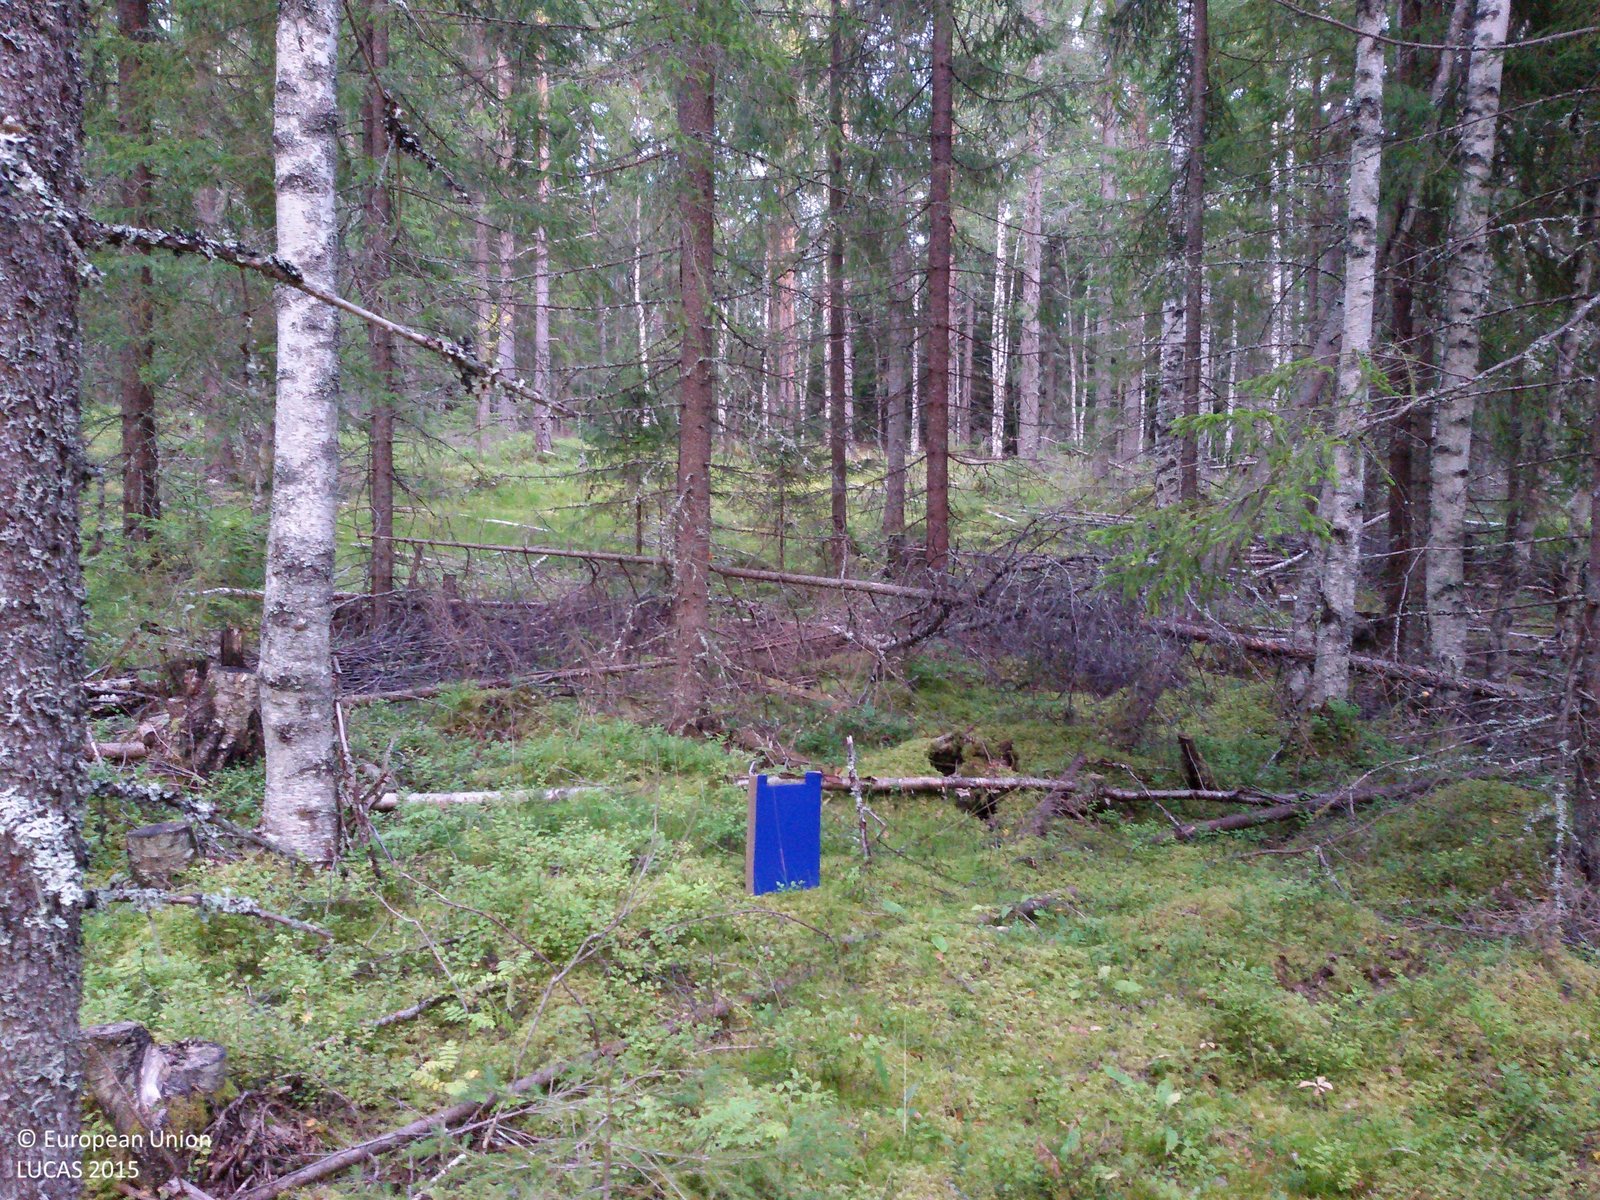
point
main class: Woodland
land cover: Spruce dominated mixed woodland
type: boreal forest
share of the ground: 50 - 75 %
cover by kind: coniferous forest trees 60 %, broadleaved forest trees 20 %, herbaceous plants 10 %, lichens and mosses 10 %
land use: Forestry
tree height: > 5 m
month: September
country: SE
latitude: 60.9919
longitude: 15.0698
